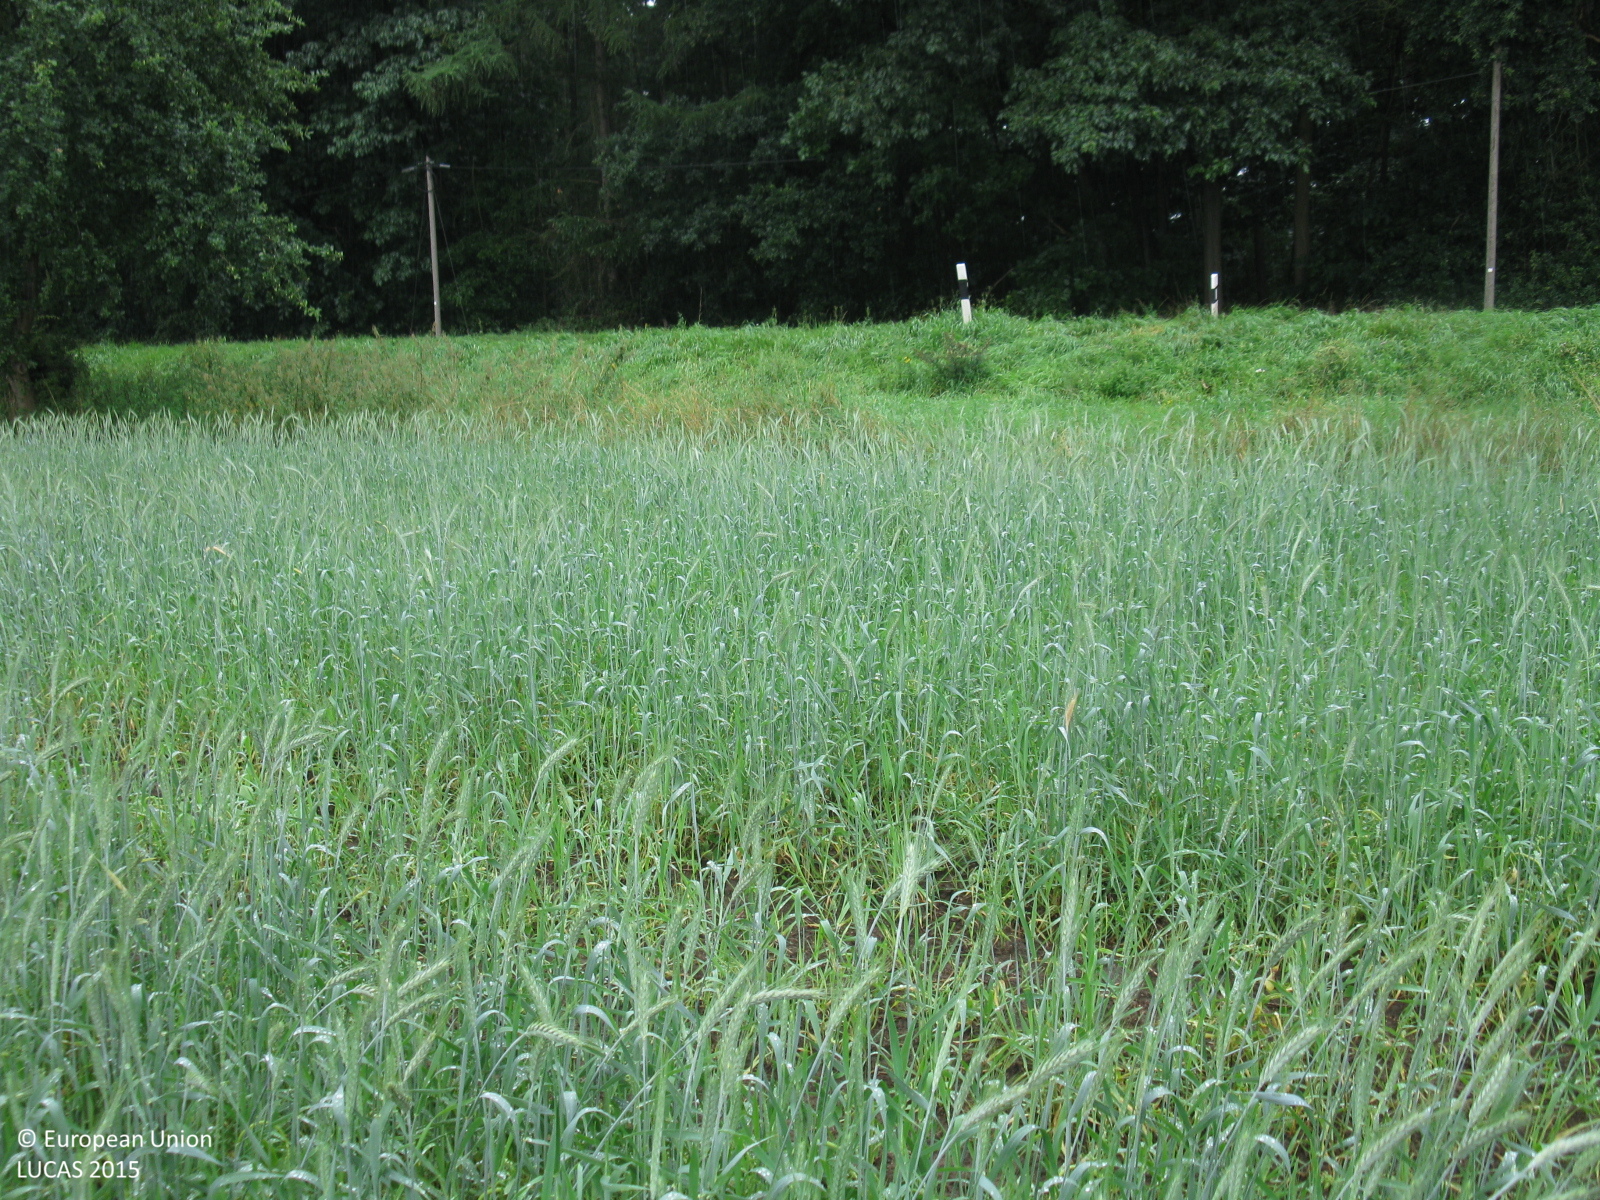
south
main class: Cropland
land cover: Rye
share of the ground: > 75 %
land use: Agriculture (excluding fallow land and kitchen gardens)
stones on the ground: < 10 %
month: August
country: DE
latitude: 51.6907
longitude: 6.9476
